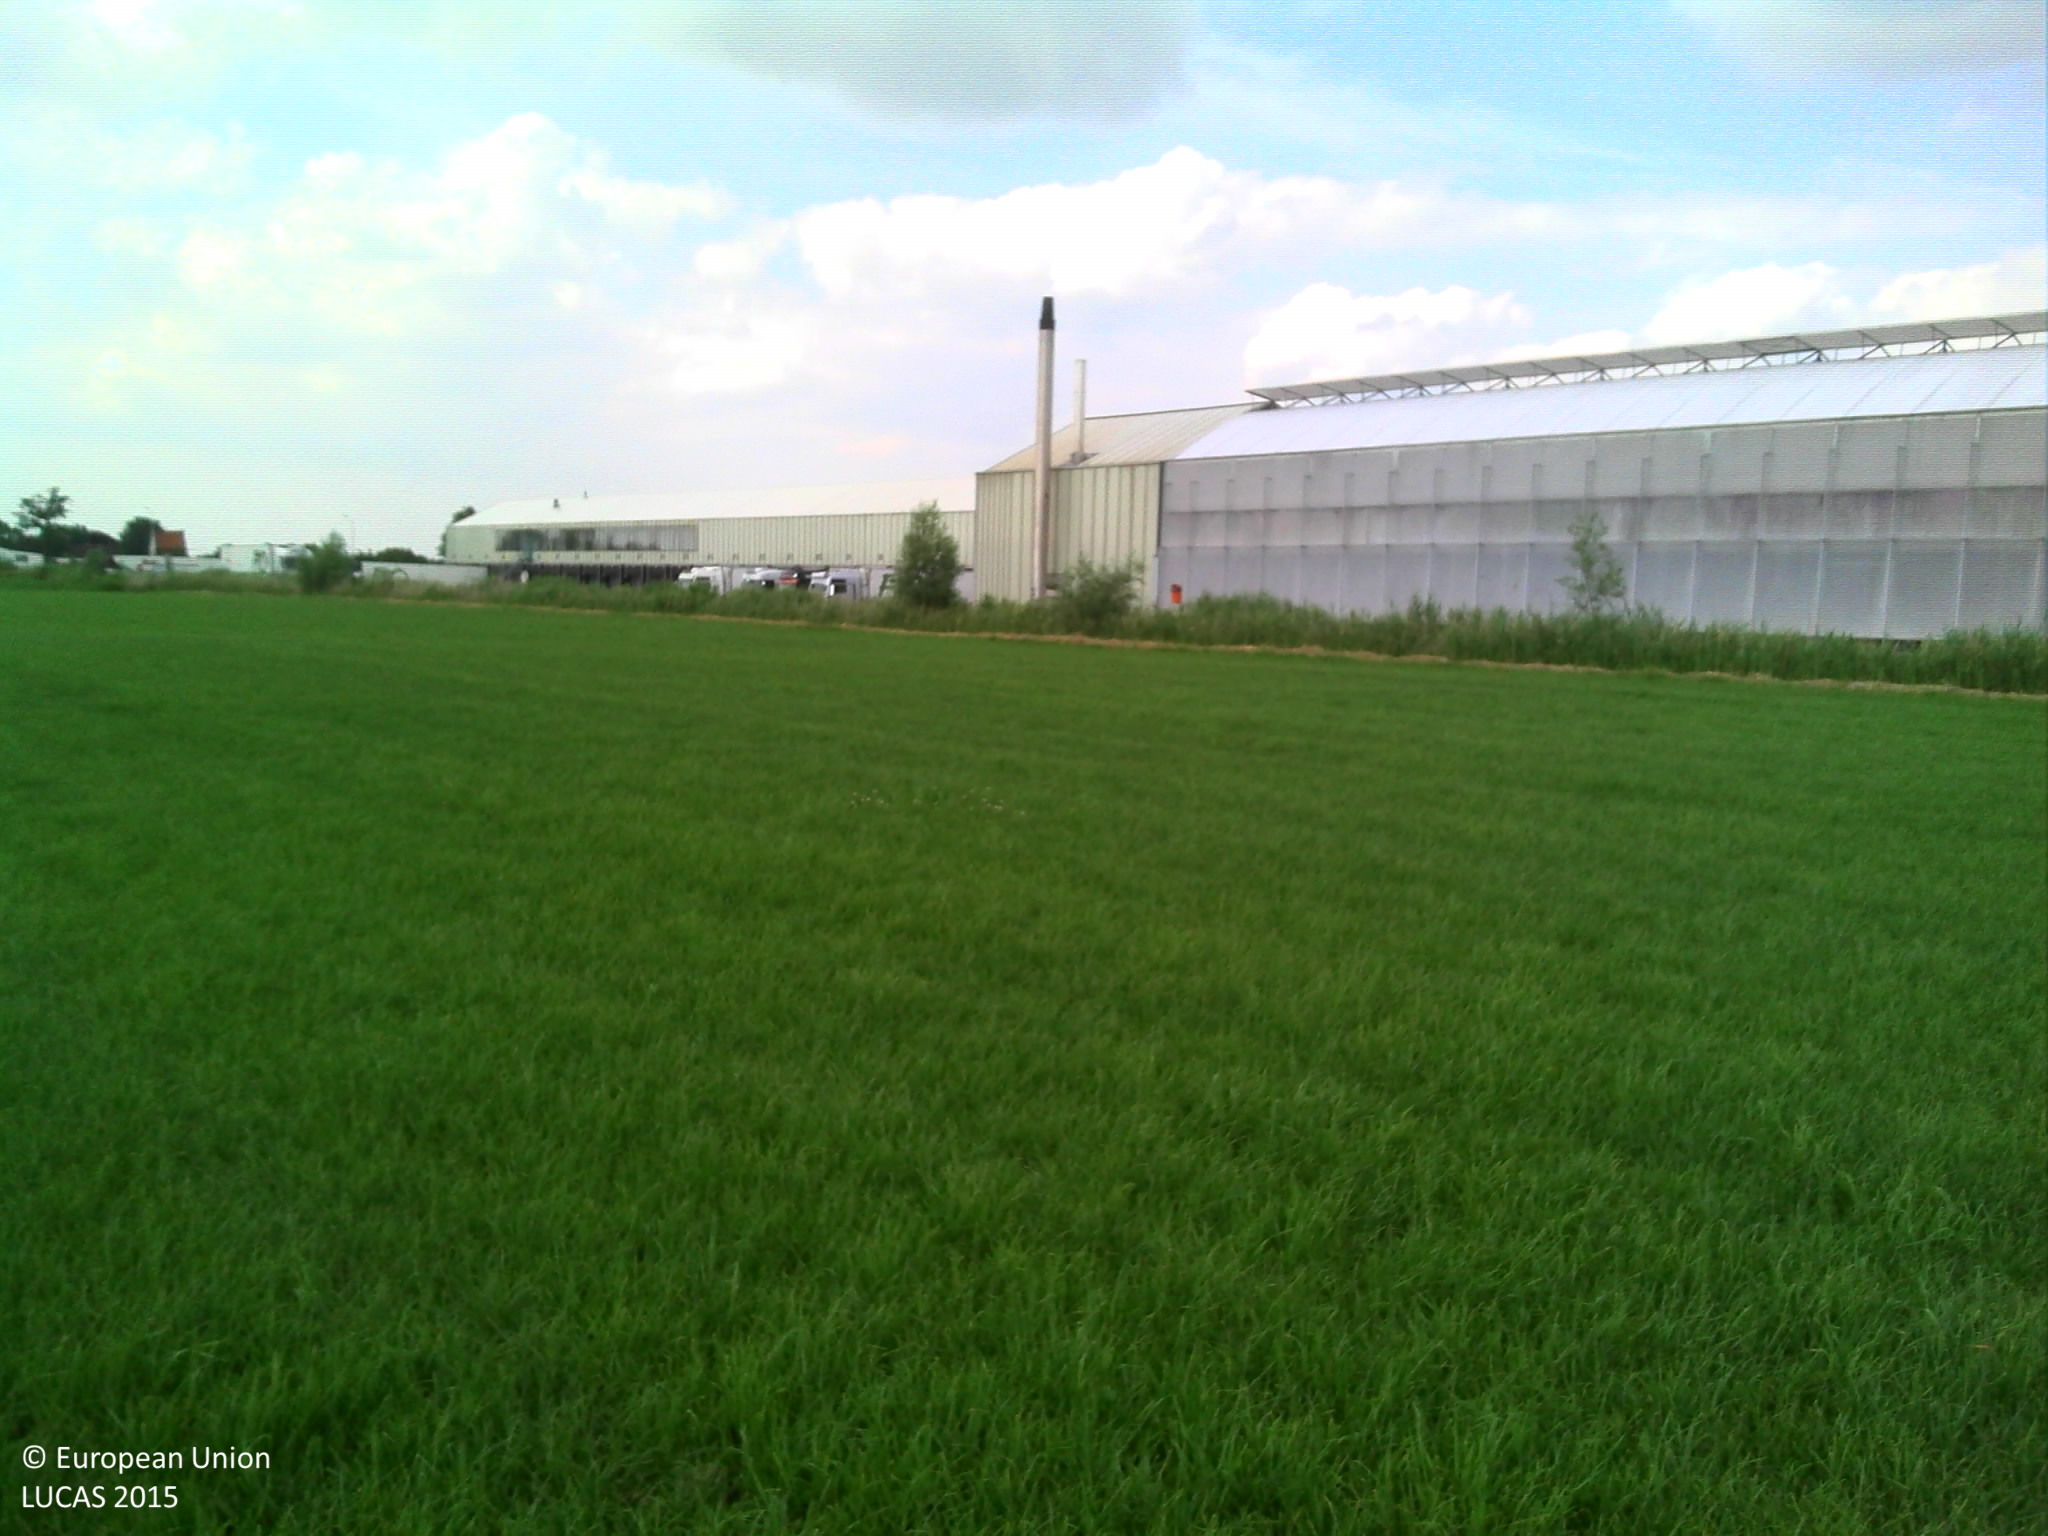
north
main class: Cropland
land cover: Temporary grasslands
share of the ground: > 75 %
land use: Agriculture (excluding fallow land and kitchen gardens)
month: June
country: BE
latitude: 51.1011
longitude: 3.8672
